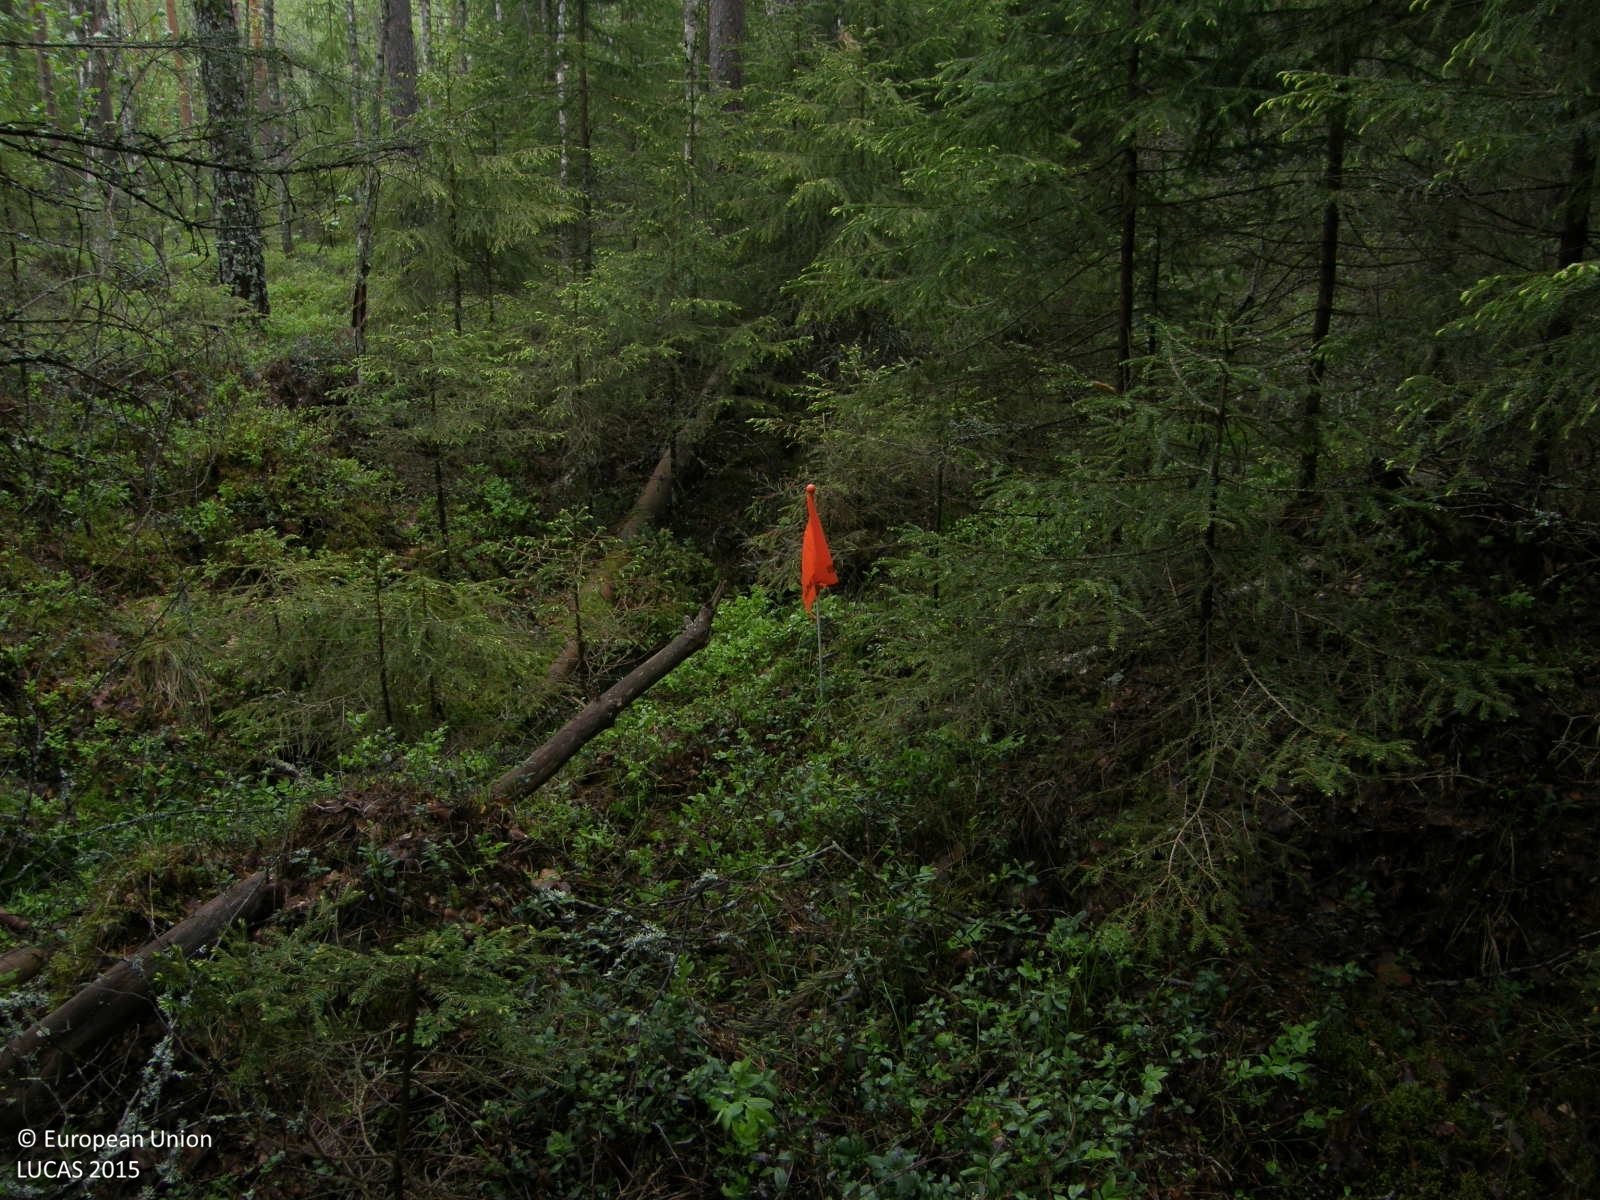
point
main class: Woodland
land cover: Other mixed woodland
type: boreal forest
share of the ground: > 75 %
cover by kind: coniferous forest trees 60 %, broadleaved forest trees 25 %, shrubs 15 %
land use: Forestry
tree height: > 5 m
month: June
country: FI
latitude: 62.0395
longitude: 21.7695
